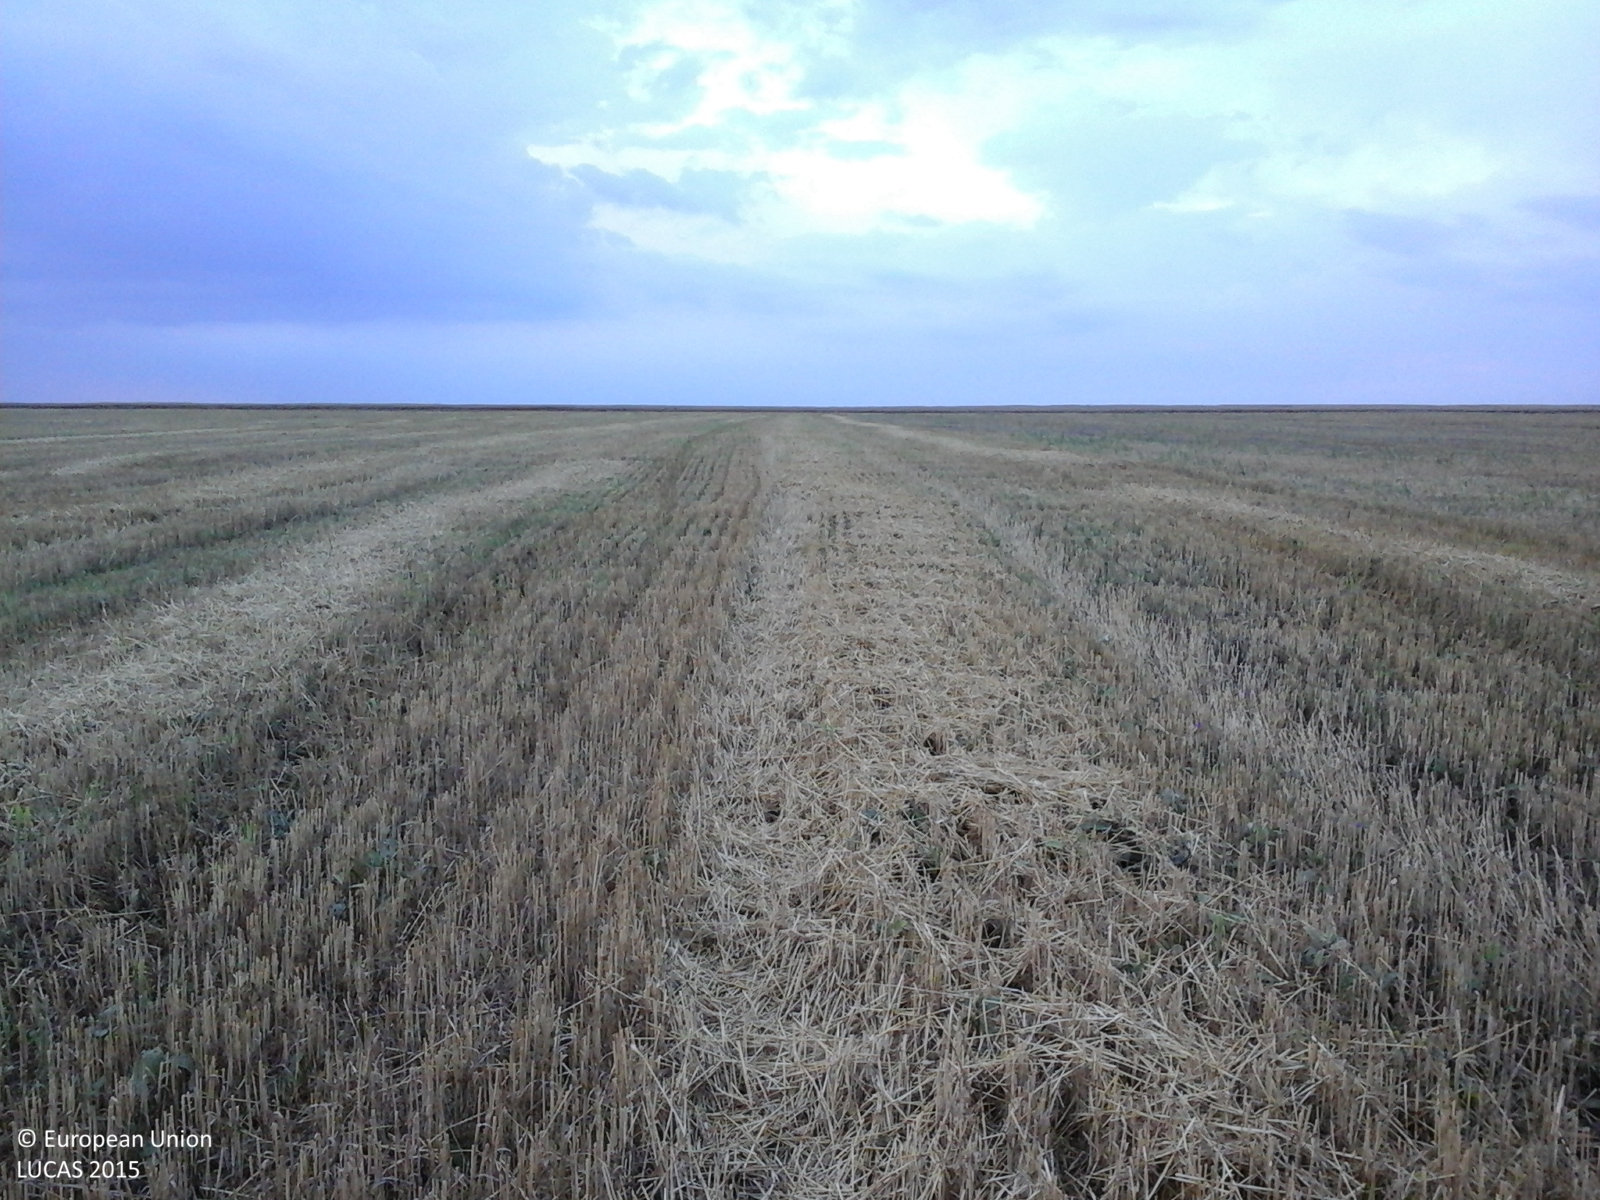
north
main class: Cropland
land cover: Common wheat
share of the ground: < 10 %
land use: Agriculture (excluding fallow land and kitchen gardens)
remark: Harvested field
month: July
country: RO
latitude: 43.9505
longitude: 24.4825
